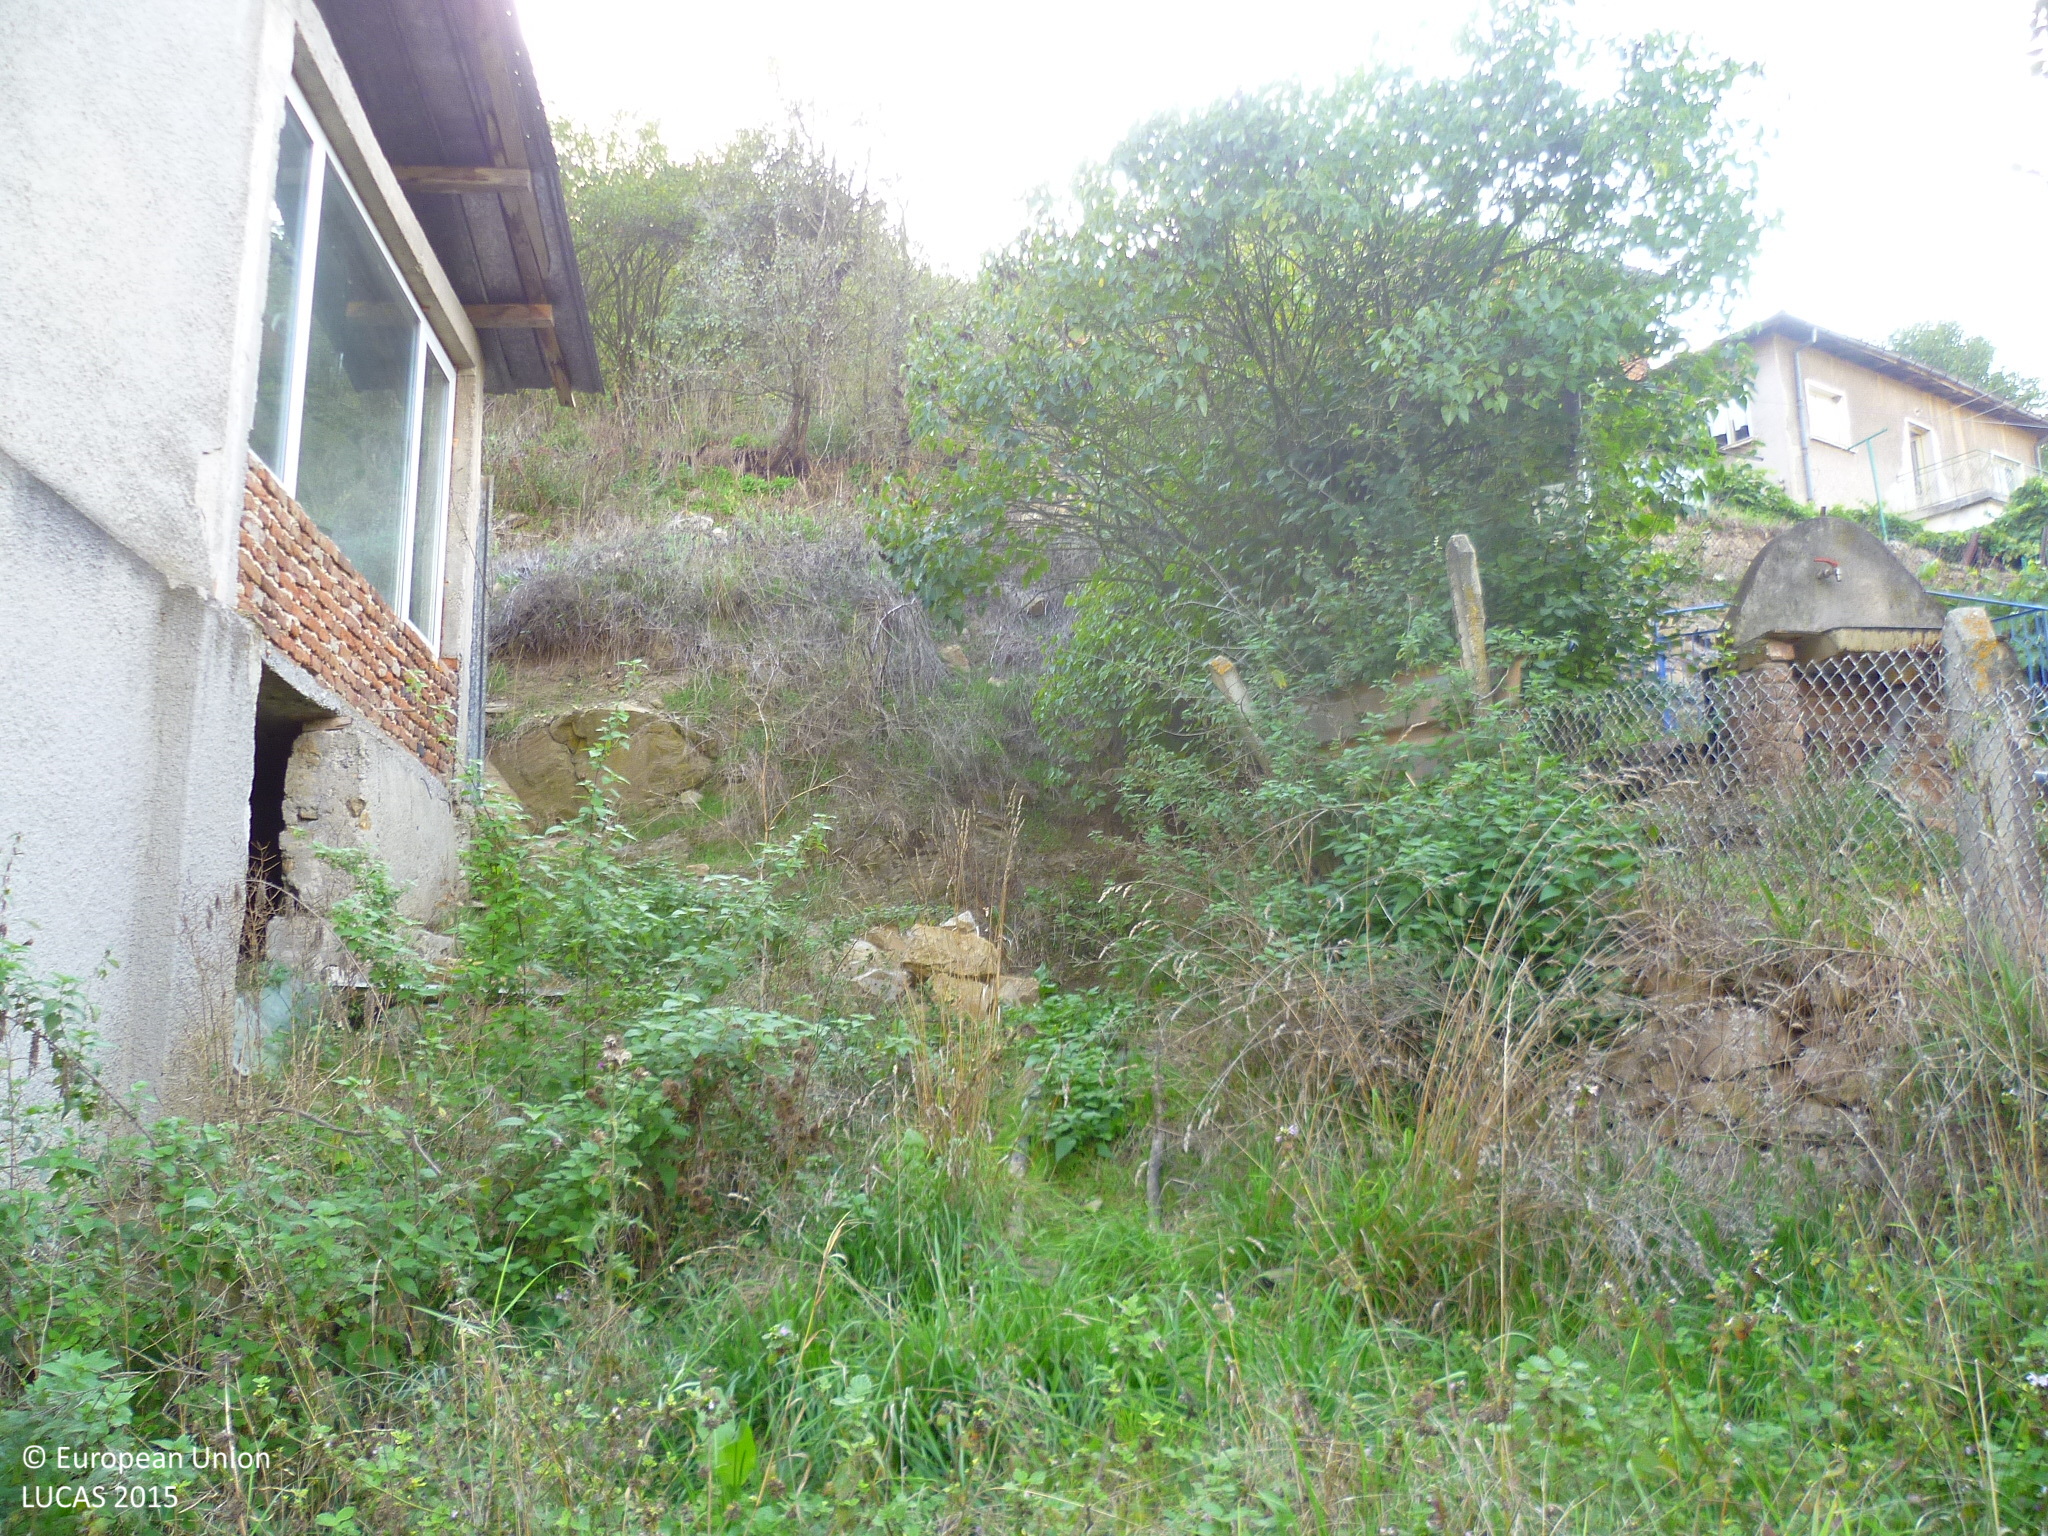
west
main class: Grassland
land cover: Grassland with sparse tree/shrub cover
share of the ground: 50 - 75 %
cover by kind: herbaceous plants 45 %, broadleaved forest trees 5 %, shrubs 5 %
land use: Residential
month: October
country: BG
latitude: 42.9147
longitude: 22.8057
